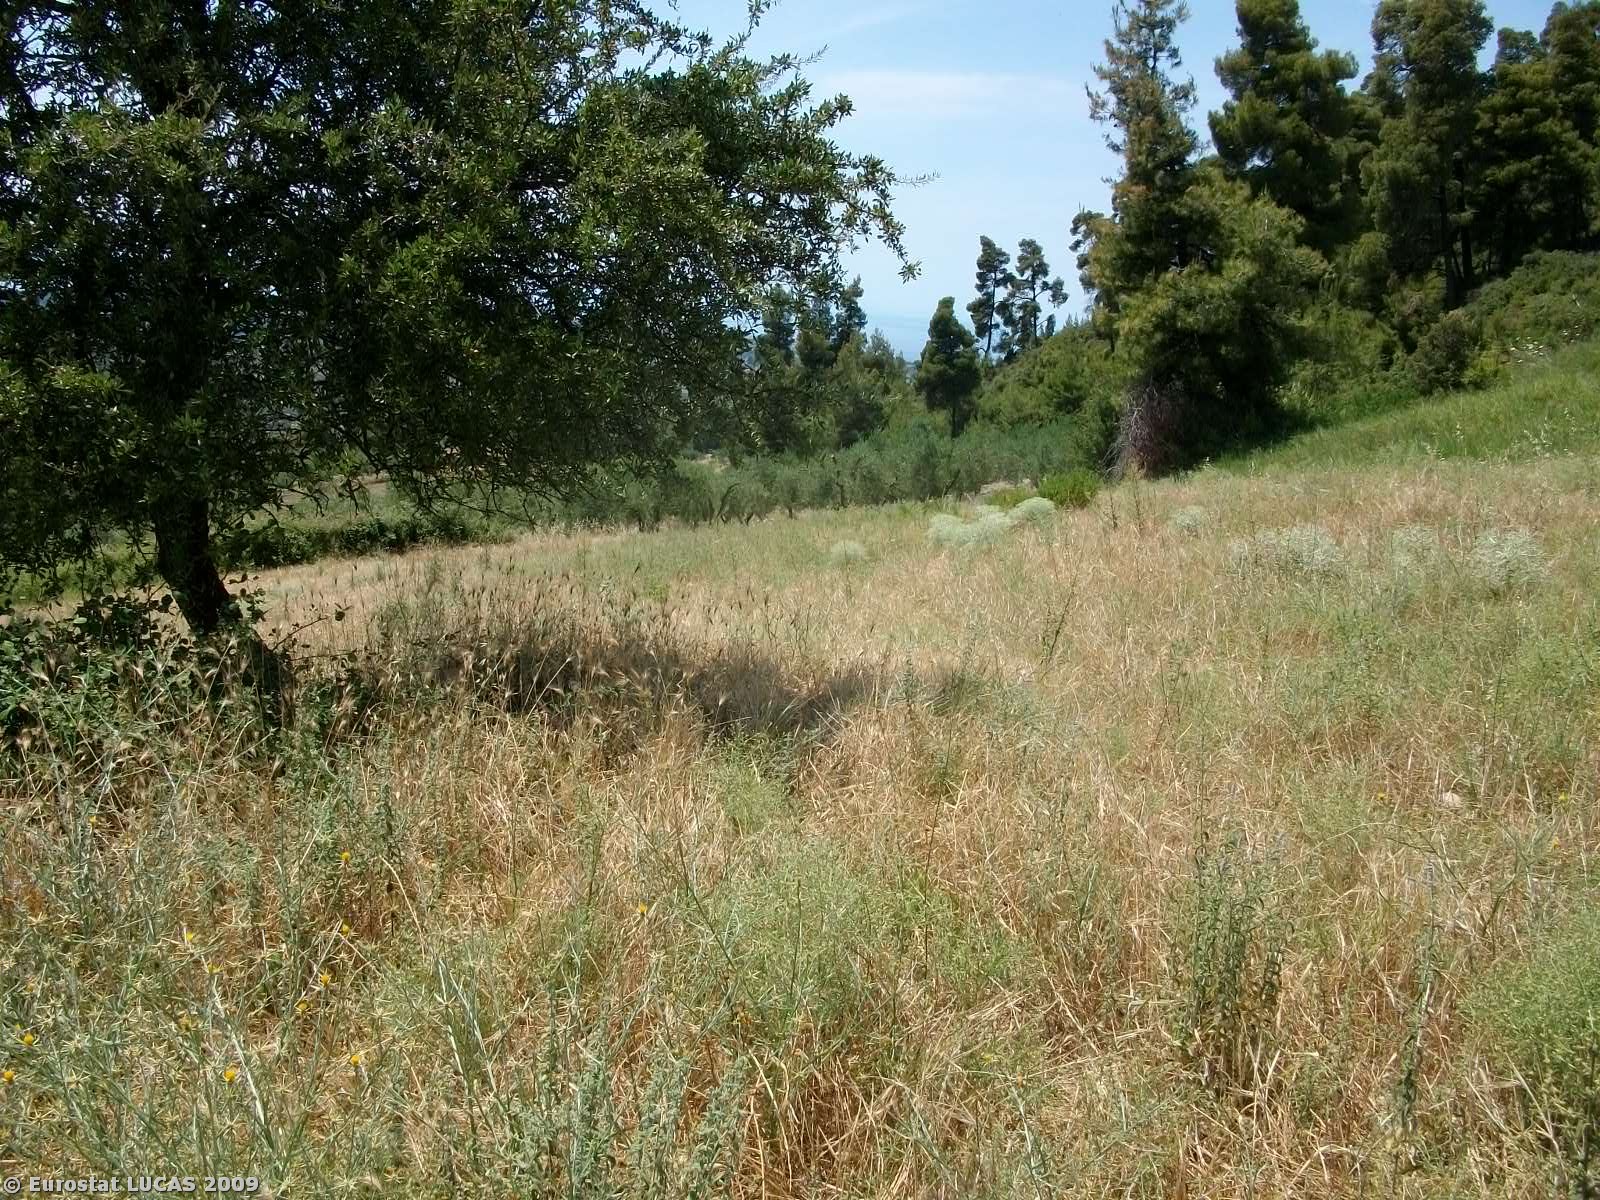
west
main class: Grassland
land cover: Grassland without tree/shrub cover
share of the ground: > 75 %
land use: Agriculture (excluding fallow land and kitchen gardens)
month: June
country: GR
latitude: 39.9795
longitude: 23.4361
